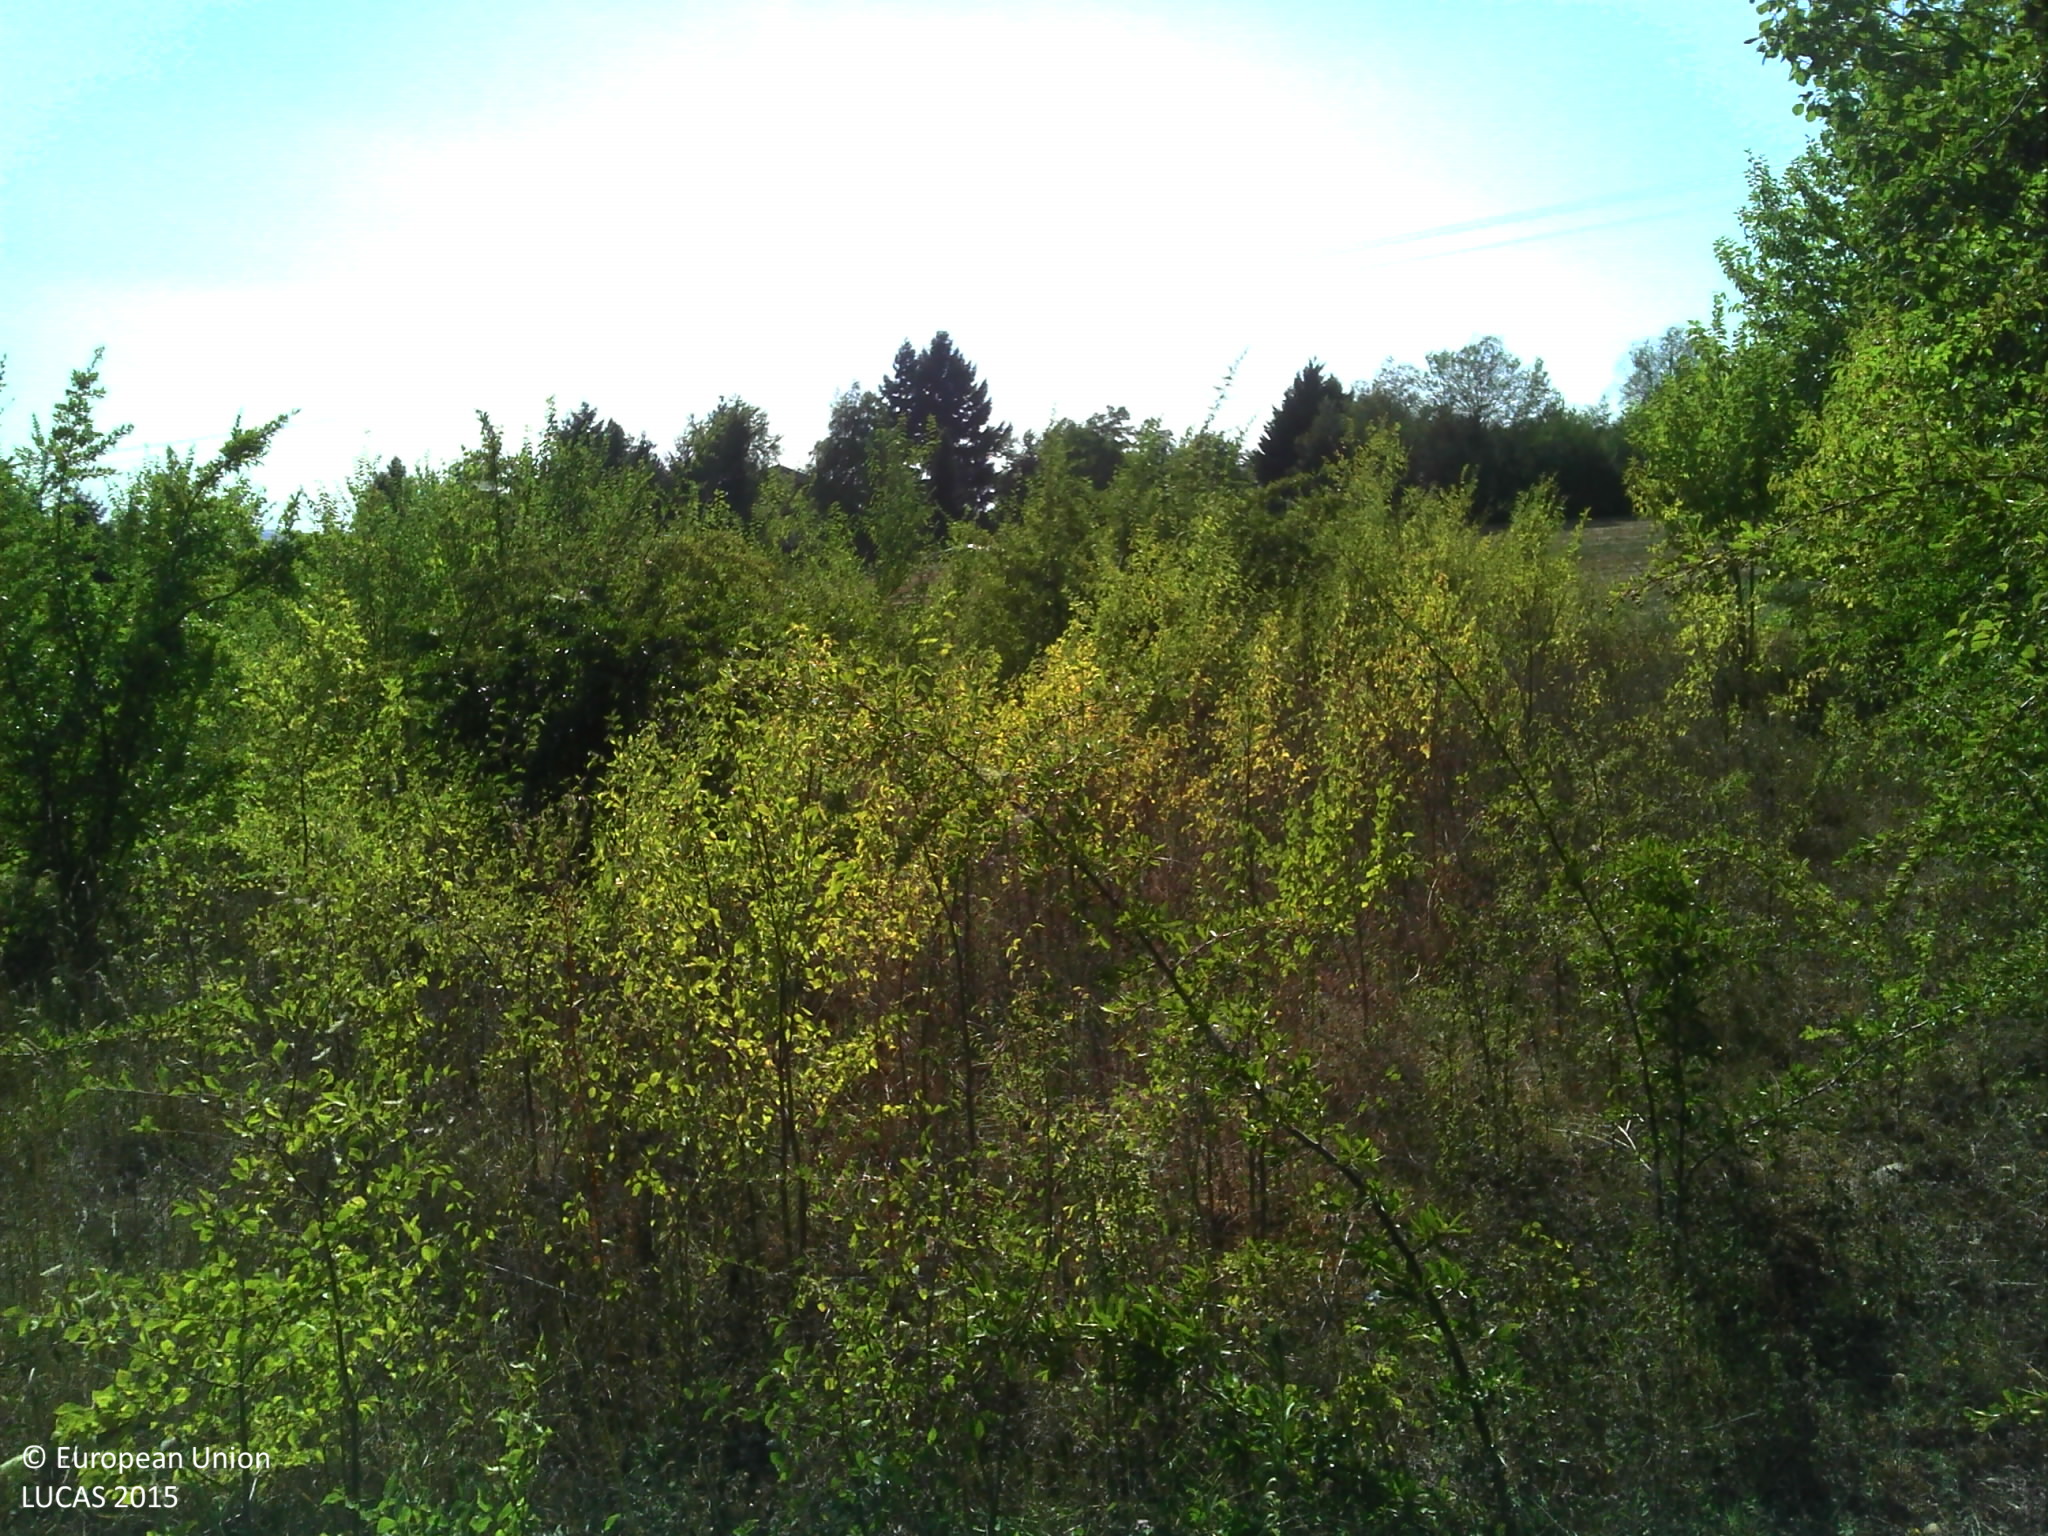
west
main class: Woodland
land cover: Broadleaved woodland
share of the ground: > 75 %
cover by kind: broadleaved forest trees 95 %, coniferous forest trees 5 %
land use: Residential
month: August
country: FR
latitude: 45.6824
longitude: 5.1637
